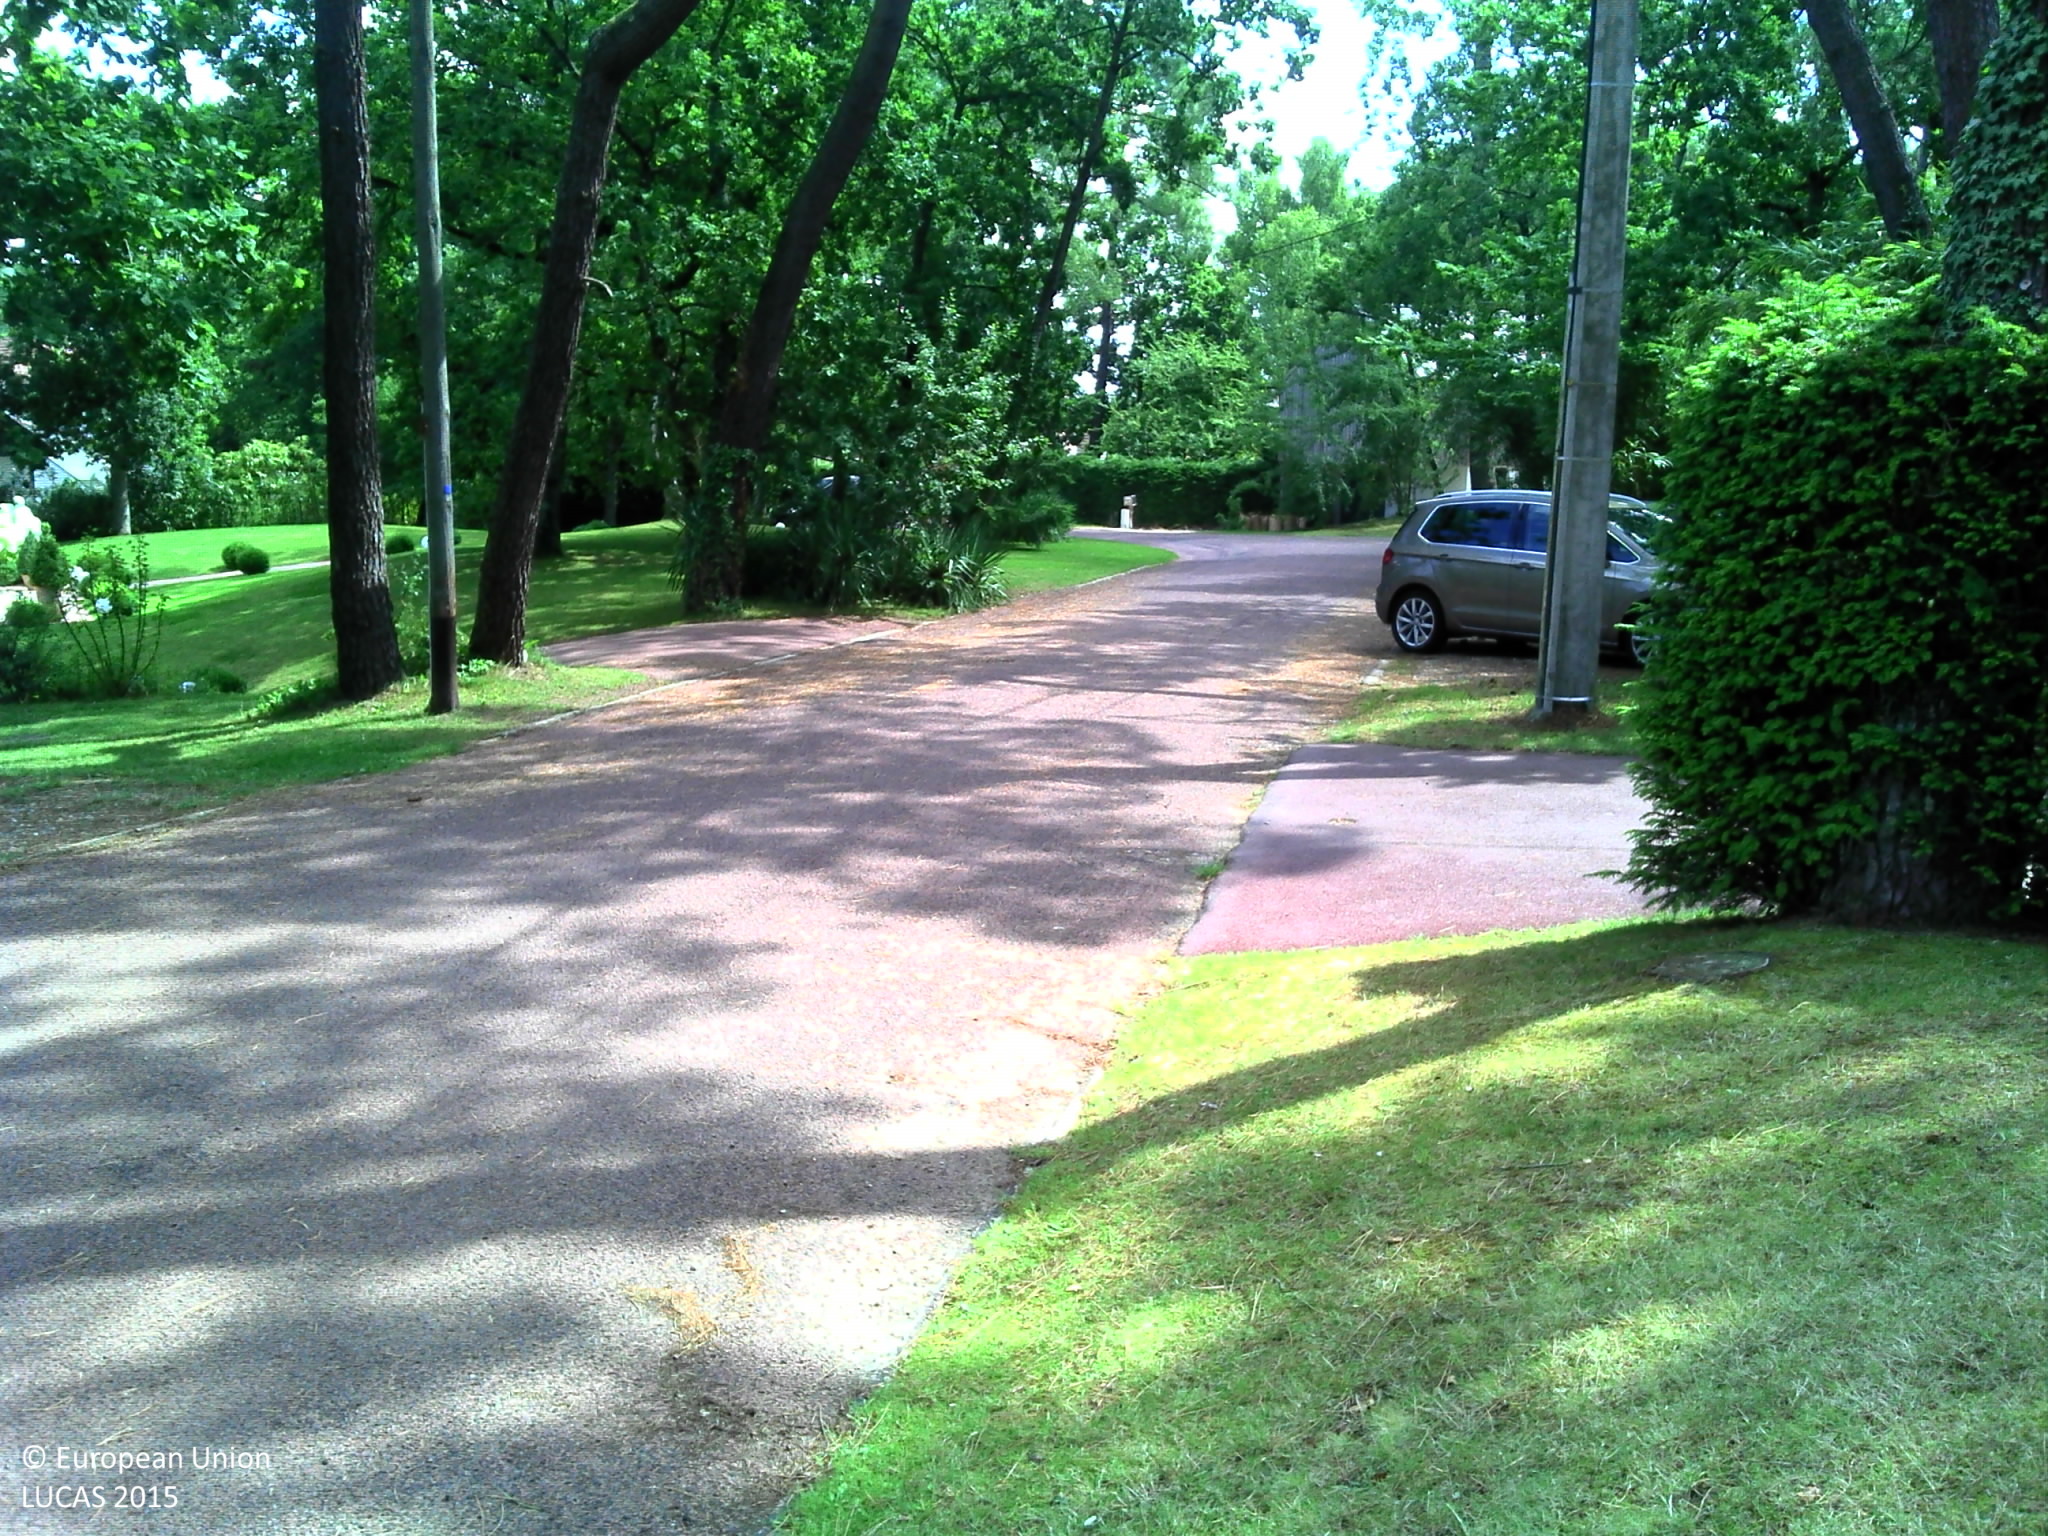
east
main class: Woodland
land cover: Pine dominated coniferous woodland
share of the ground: 50 - 75 %
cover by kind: herbaceous plants 60 %, coniferous forest trees 40 %
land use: Residential
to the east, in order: Pine dominated coniferous woodland; Artificial constructions in urban areas
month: July
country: FR
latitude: 50.5081
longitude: 1.6199
